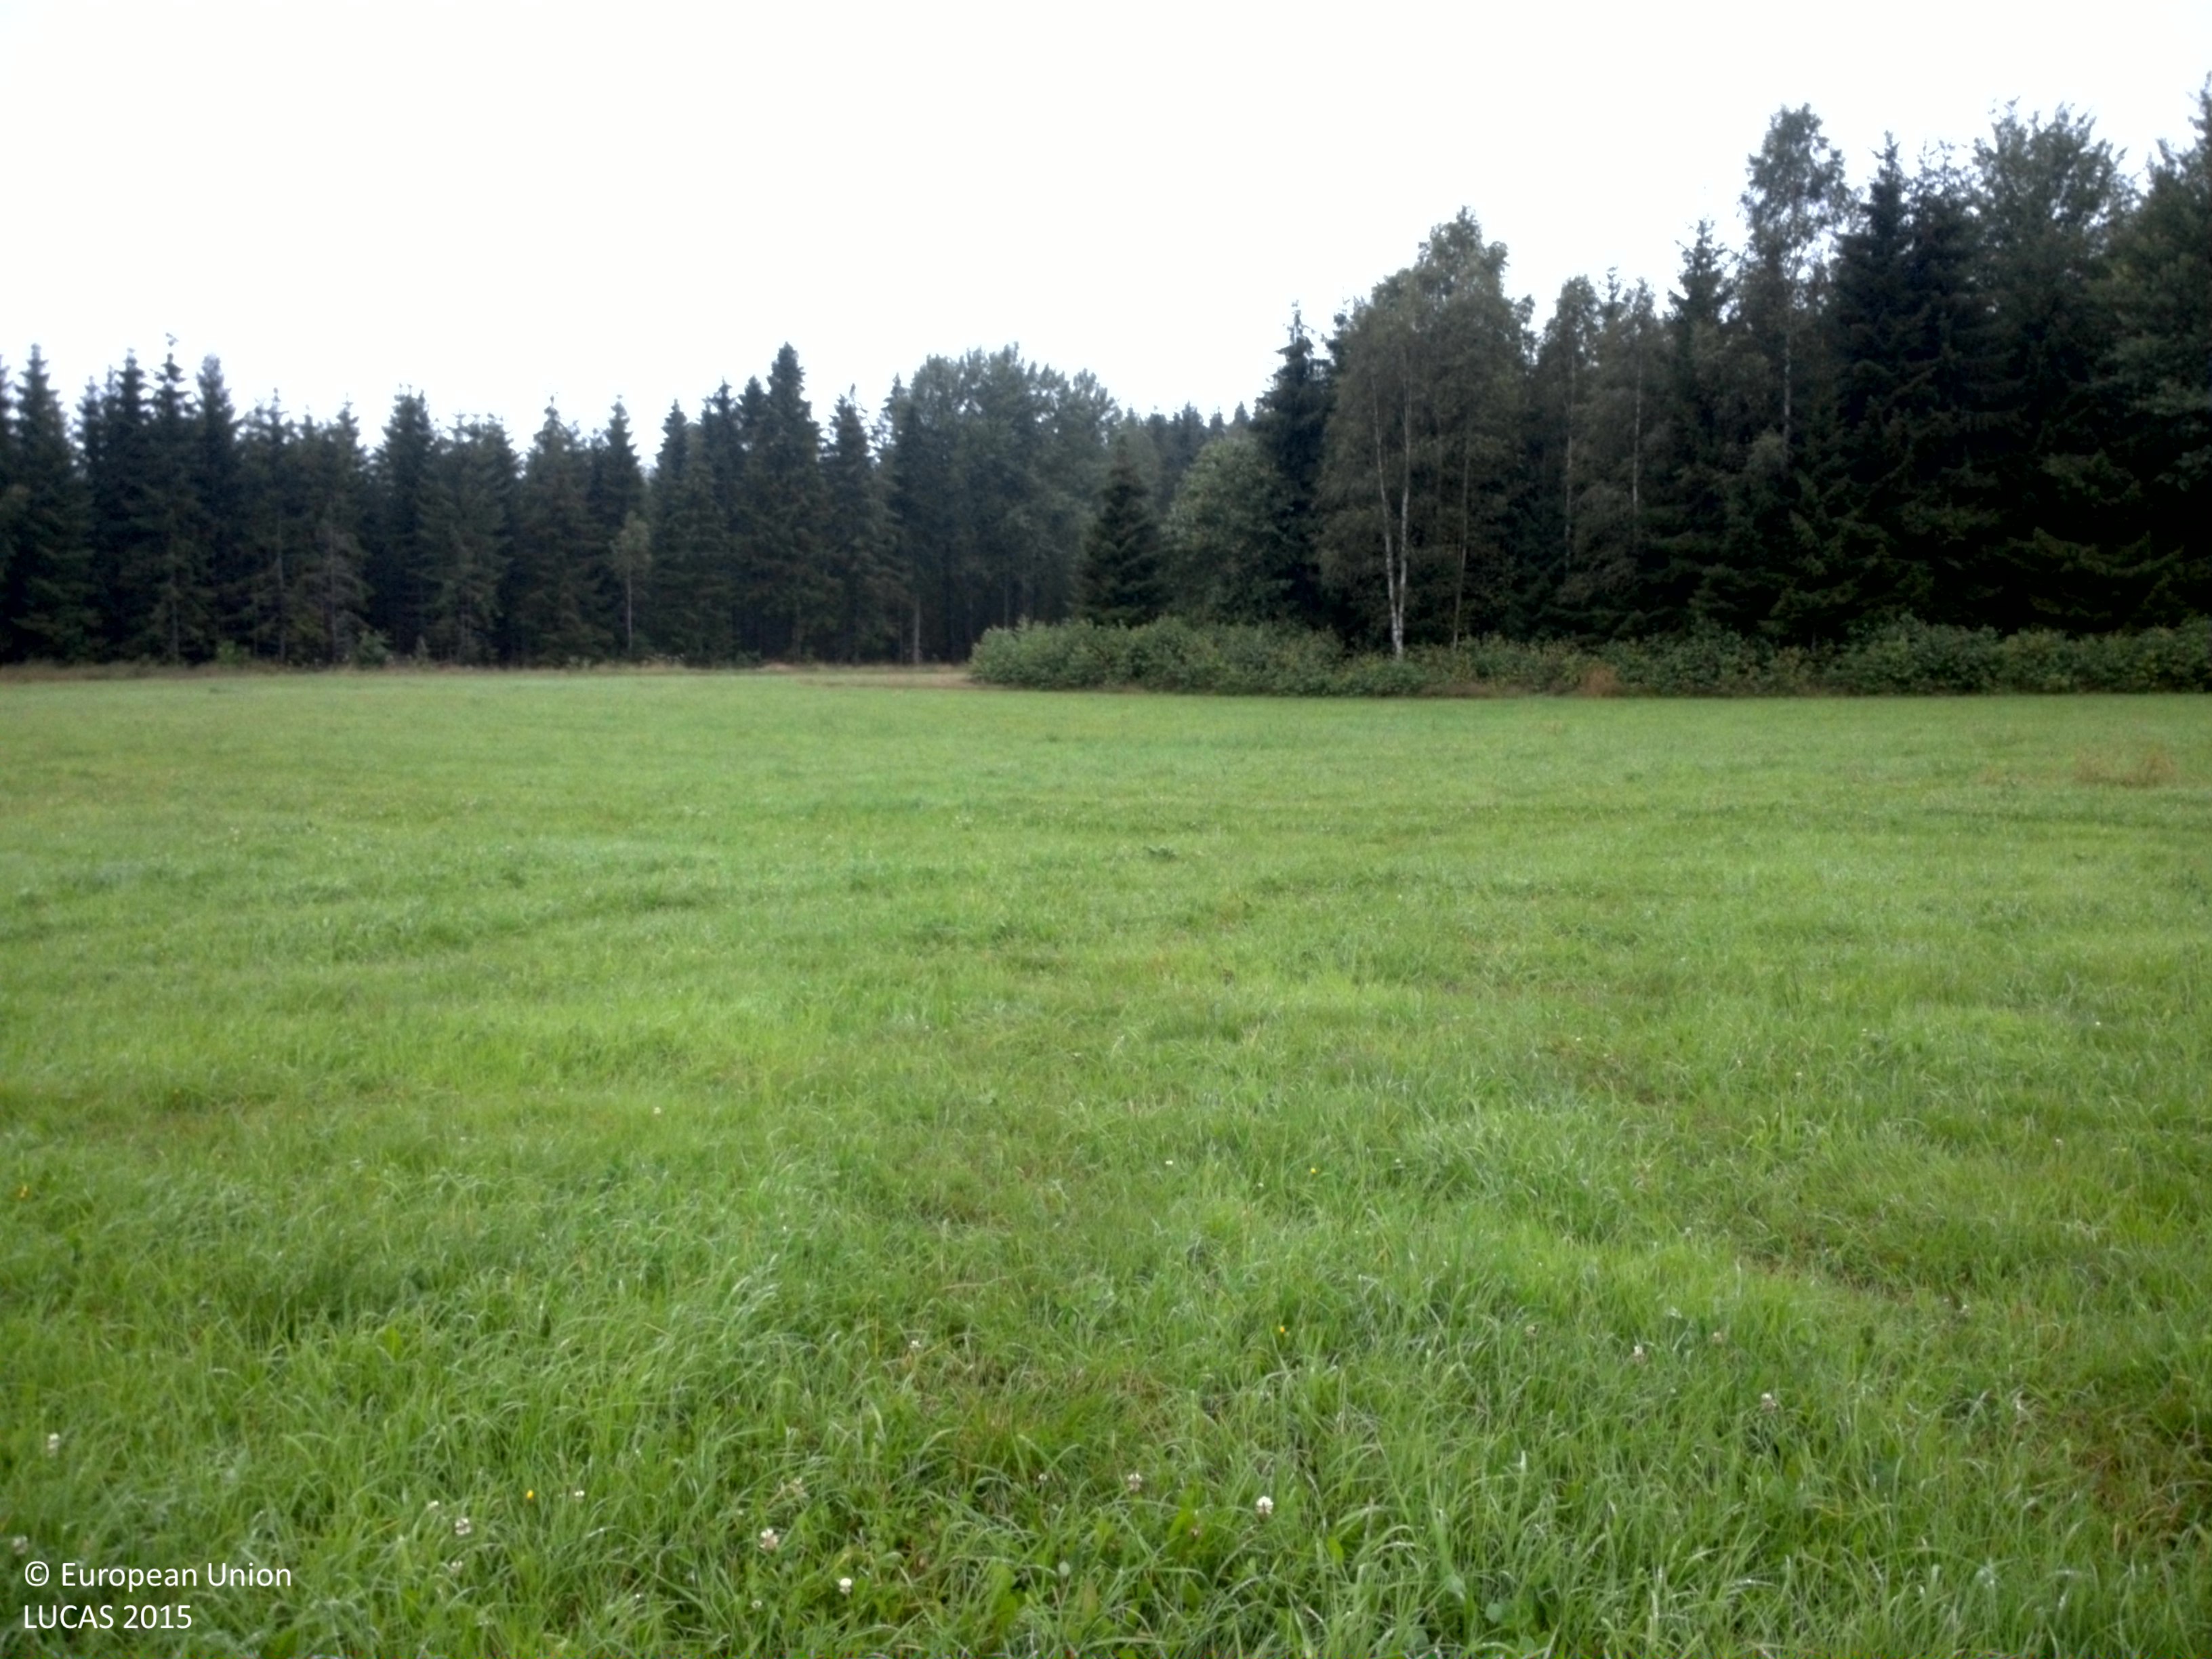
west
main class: Cropland
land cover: Temporary grasslands
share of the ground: 50 - 75 %
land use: Agriculture (excluding fallow land and kitchen gardens)
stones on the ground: < 10 %
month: August
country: SE
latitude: 59.3891
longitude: 13.1442
